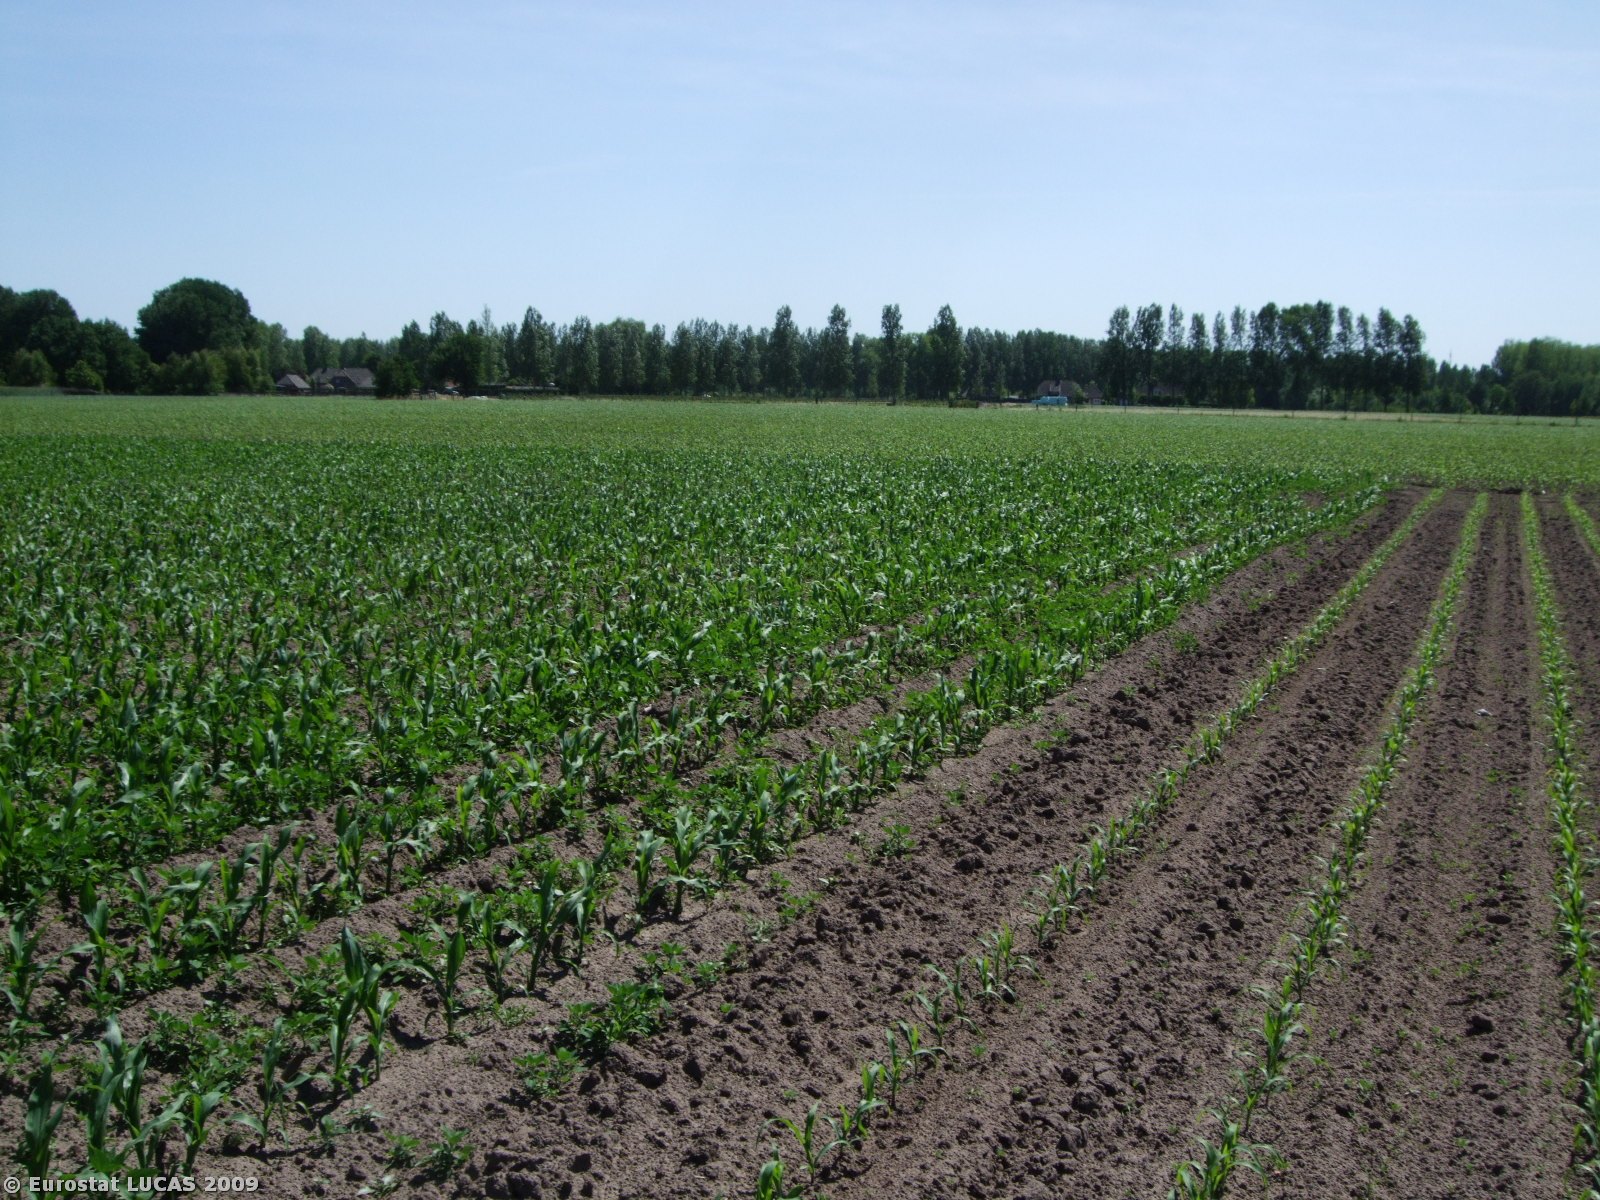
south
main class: Cropland
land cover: Maize
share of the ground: 25 - 50 %
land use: Agriculture (excluding fallow land and kitchen gardens)
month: June
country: NL
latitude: 51.5669
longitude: 5.3670
